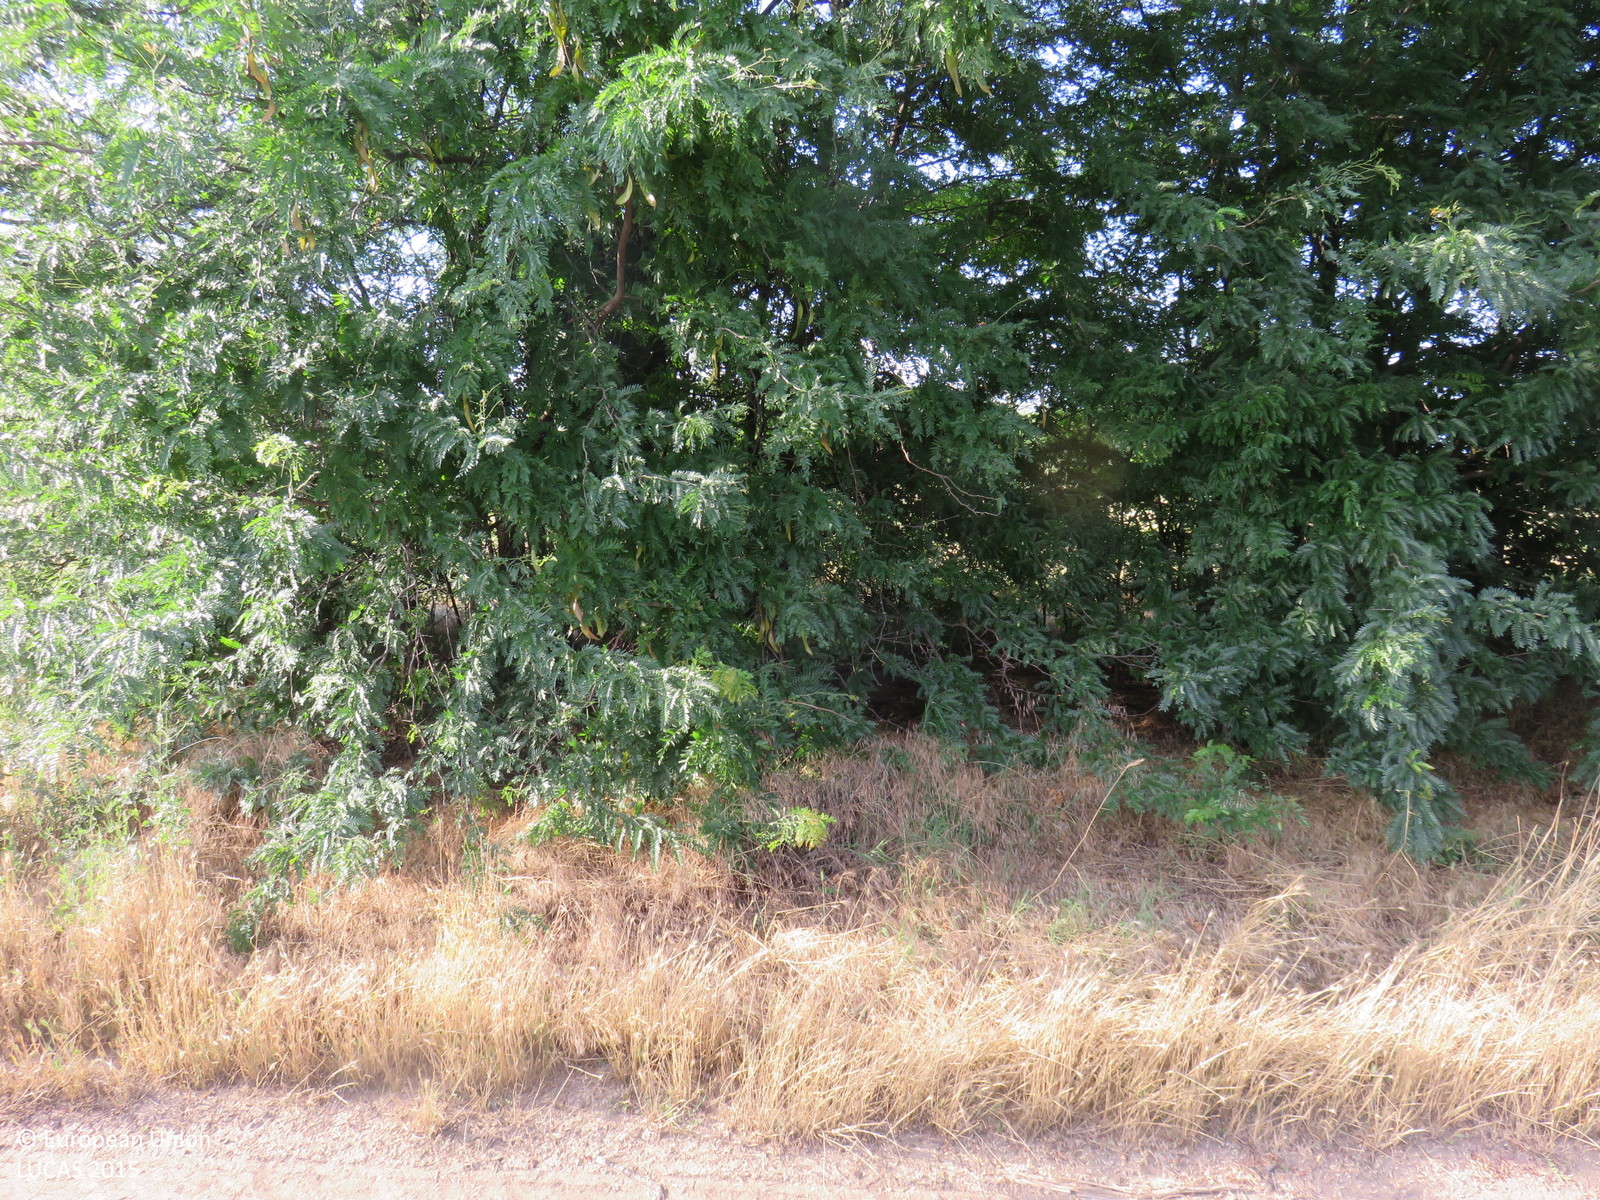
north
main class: Cropland
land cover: Maize
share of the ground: > 75 %
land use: Agriculture (excluding fallow land and kitchen gardens)
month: June
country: BG
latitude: 43.3717
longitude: 24.9400
